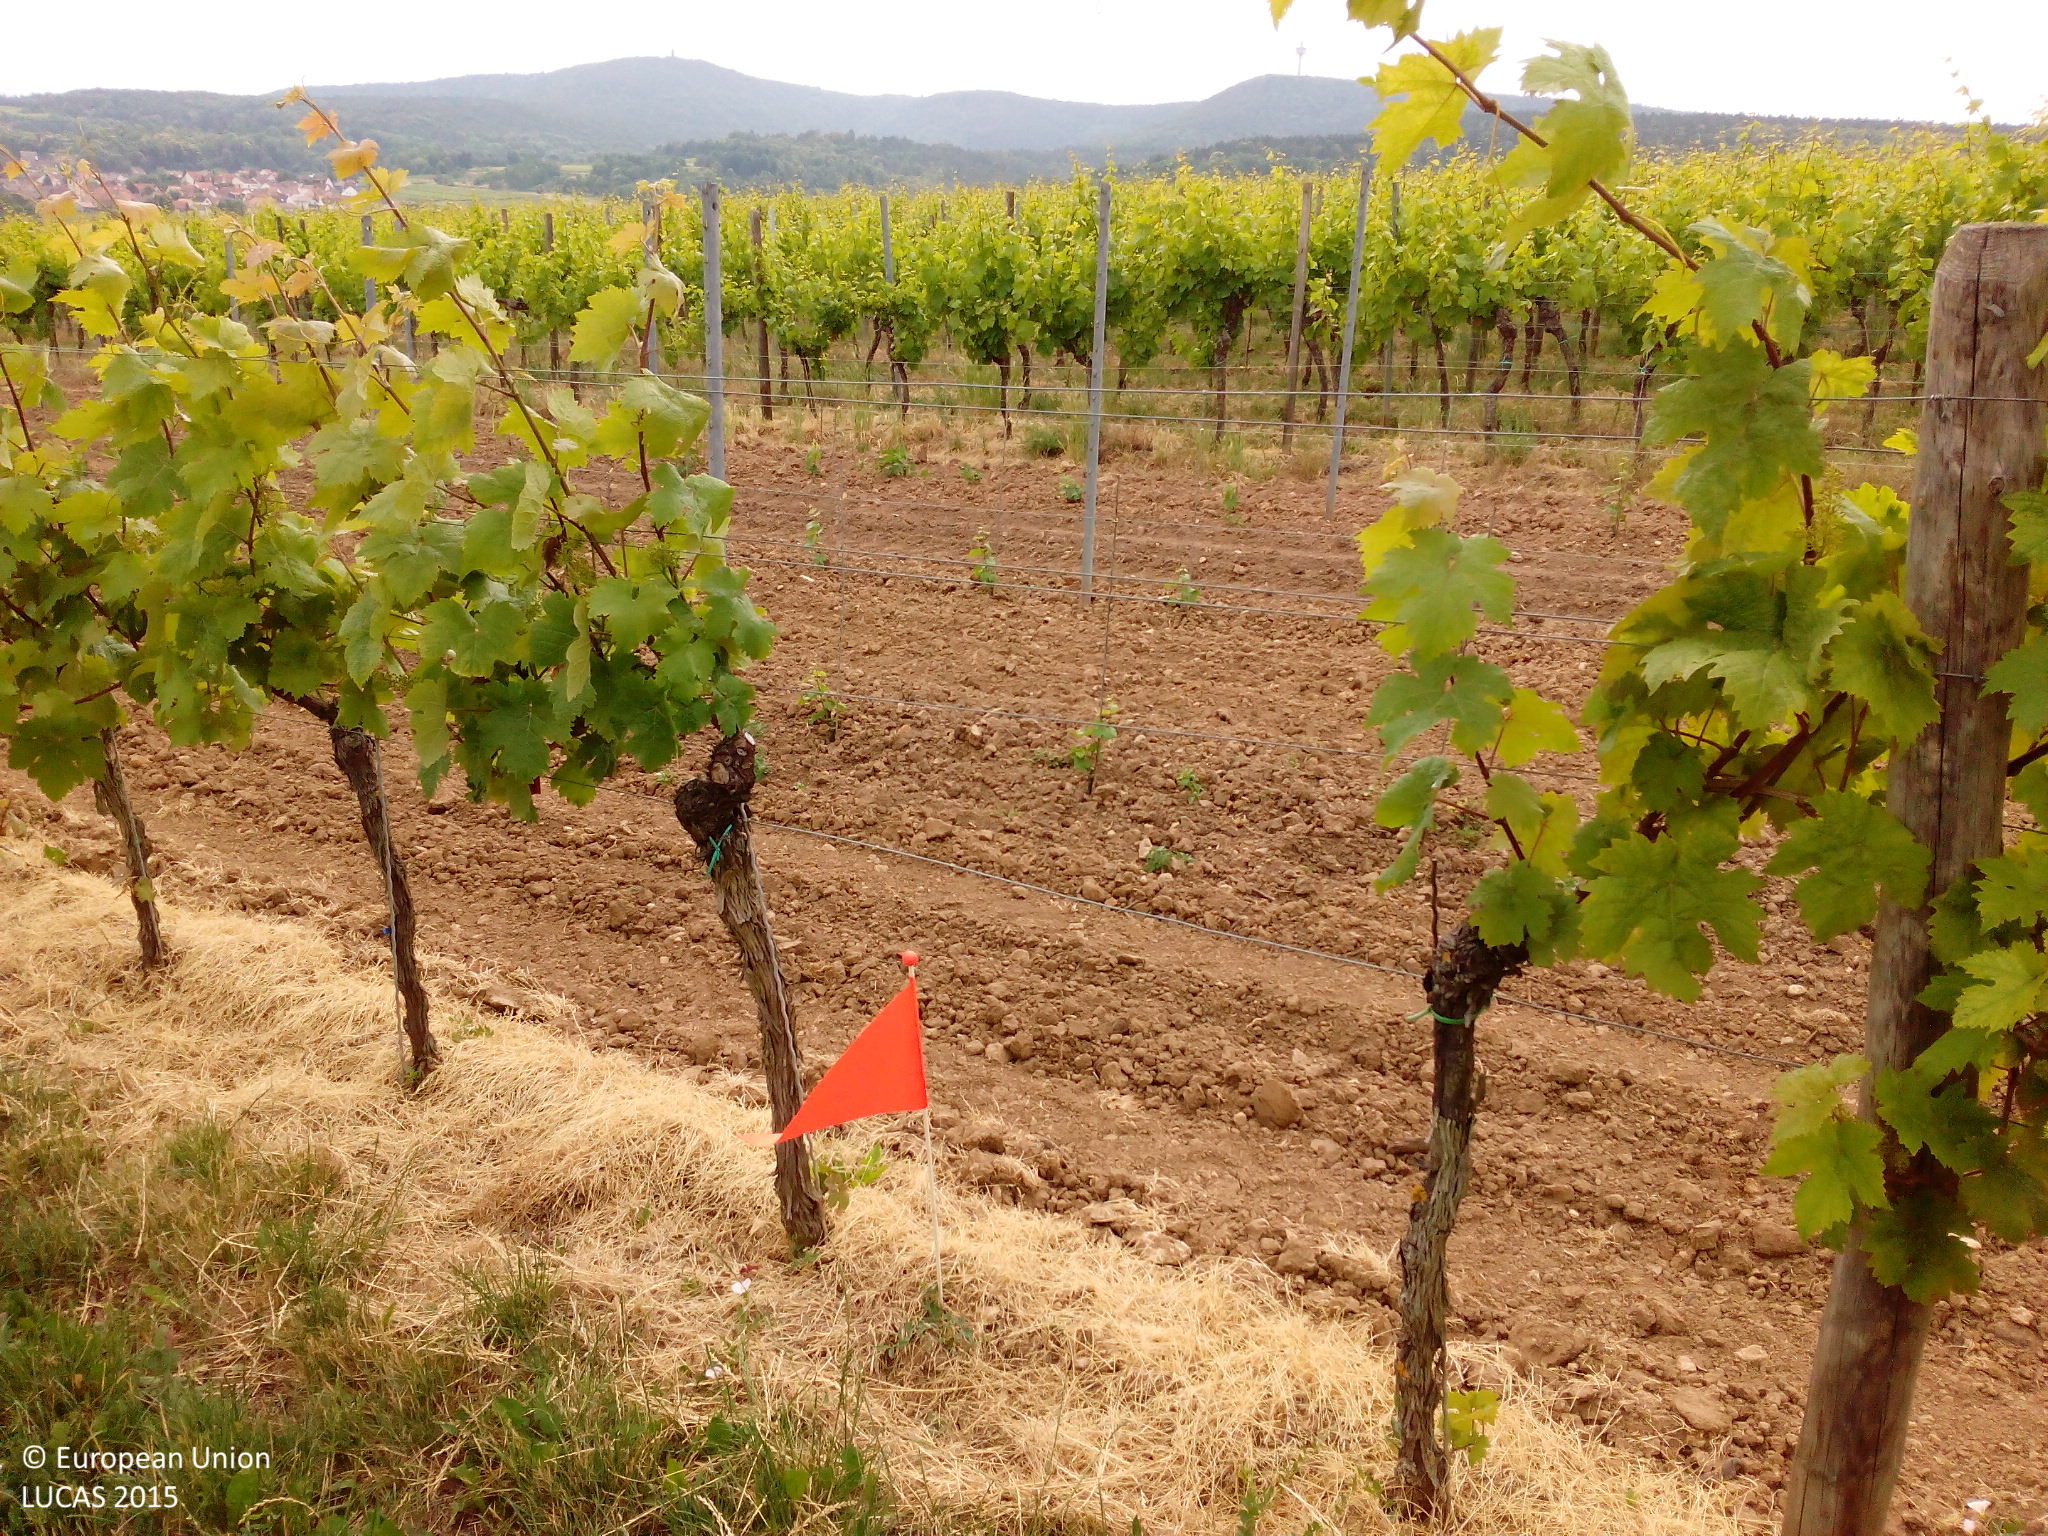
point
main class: Cropland
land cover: Vineyards
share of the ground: 10 - 25 %
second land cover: Spontaneously vegetated surfaces
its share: 25 - 50 %
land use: Agriculture (excluding fallow land and kitchen gardens)
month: June
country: DE
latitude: 49.5039
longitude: 8.1639
